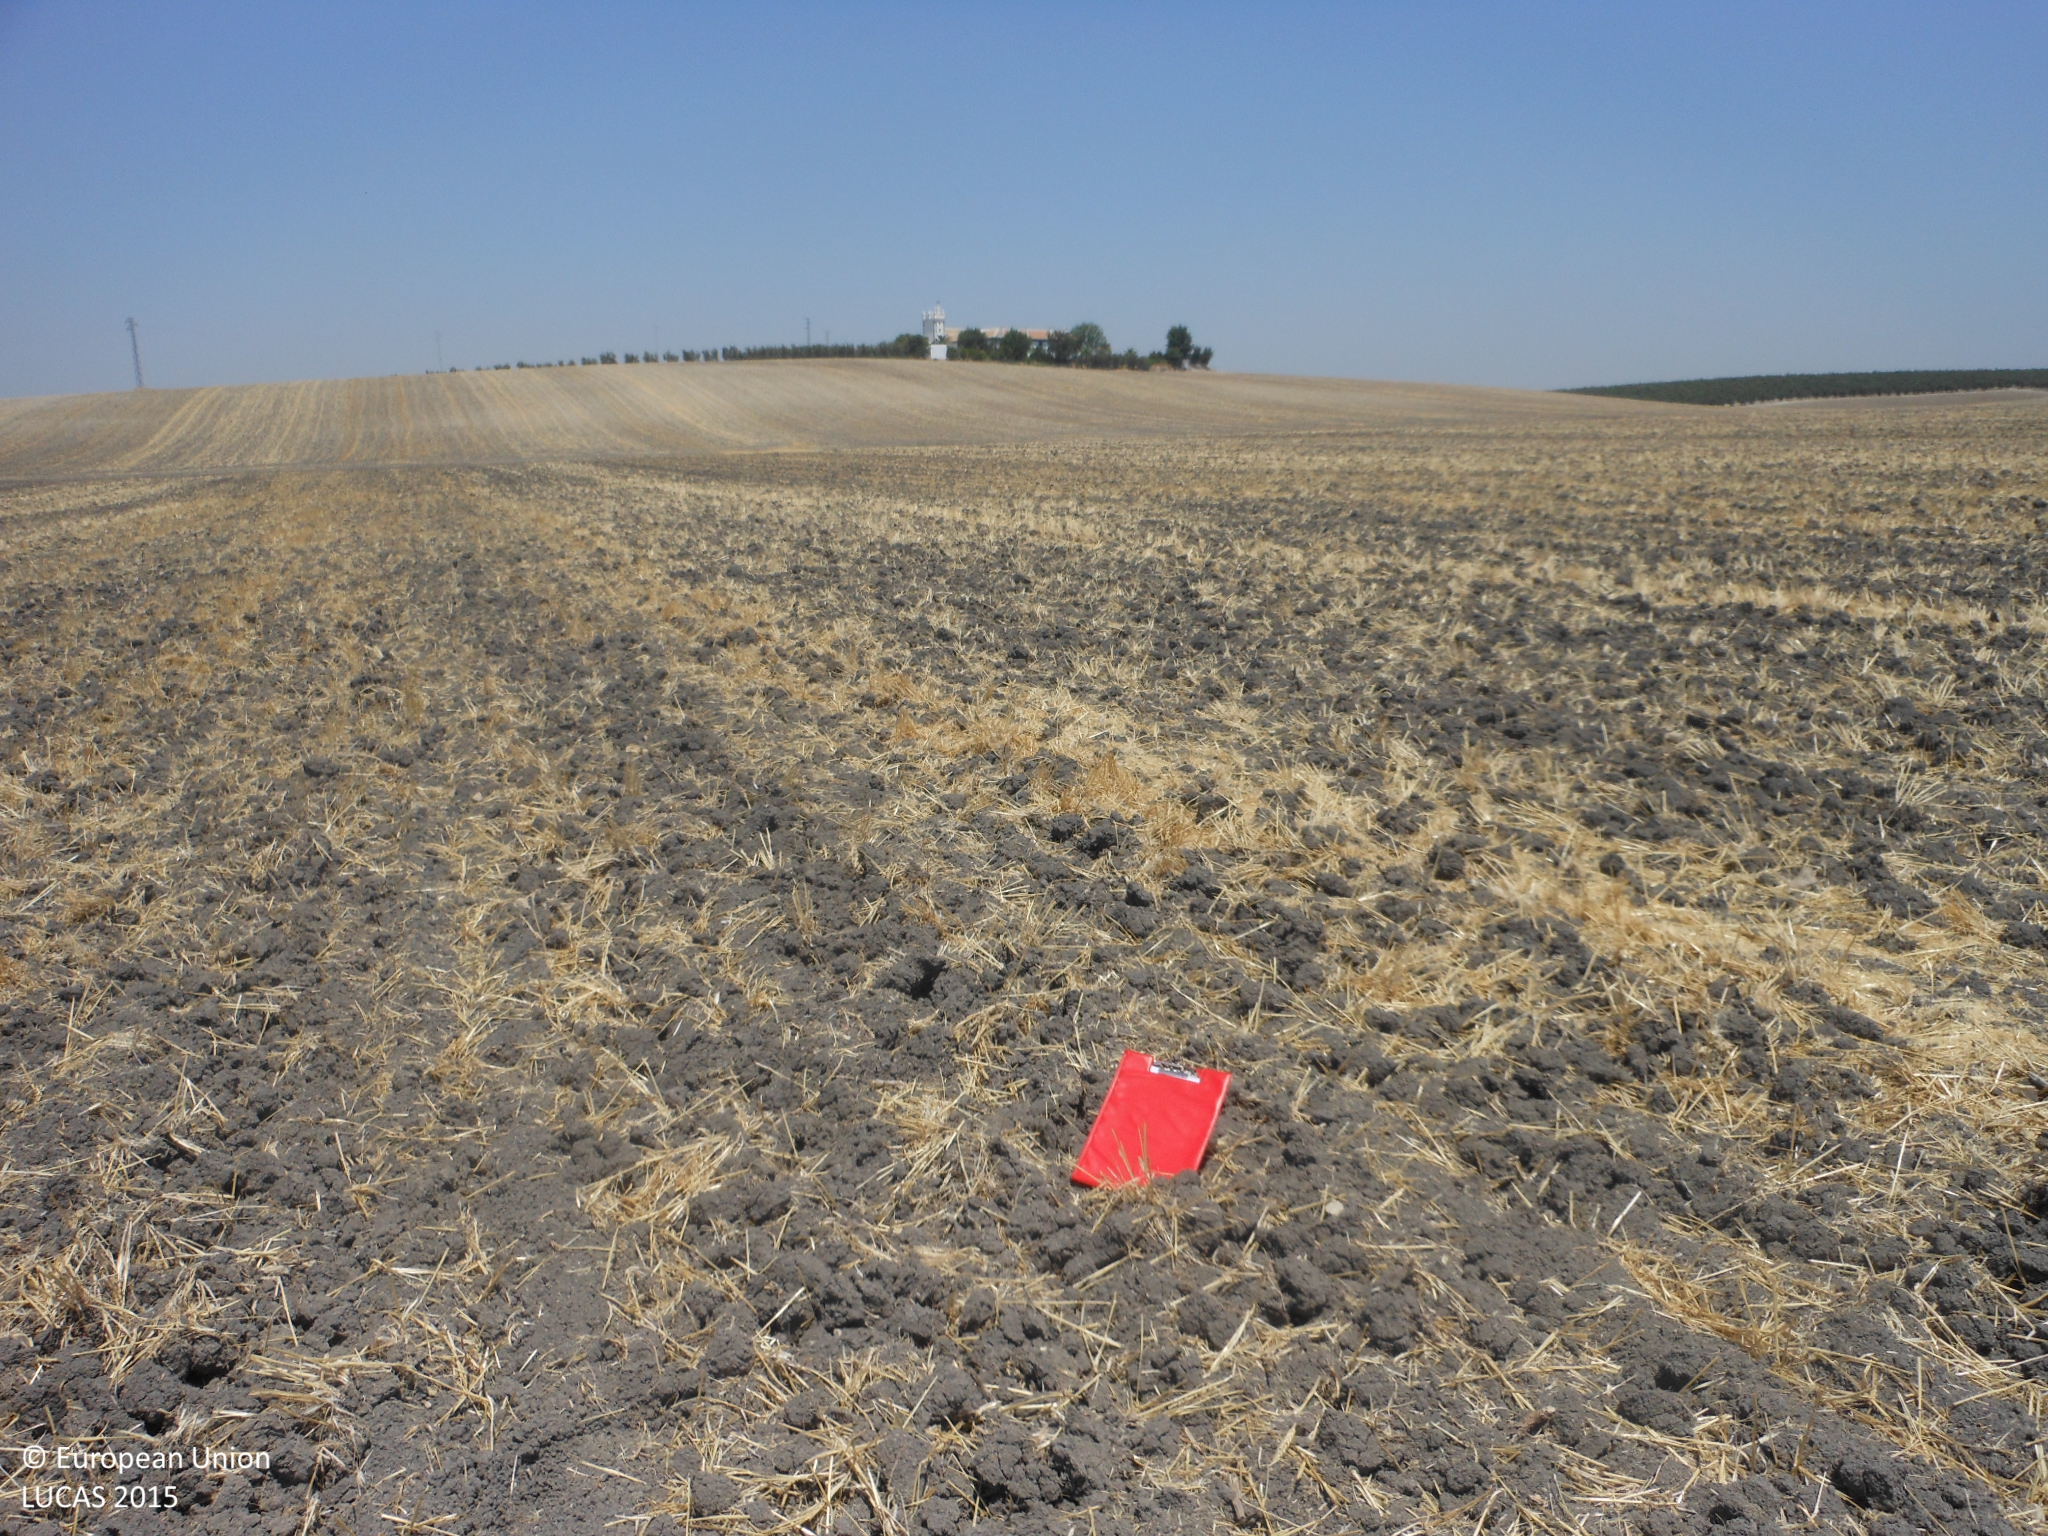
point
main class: Cropland
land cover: Common wheat
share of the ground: < 10 %
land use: Agriculture (excluding fallow land and kitchen gardens)
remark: Harvested field
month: June
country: ES
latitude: 37.1297
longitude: -5.5110
